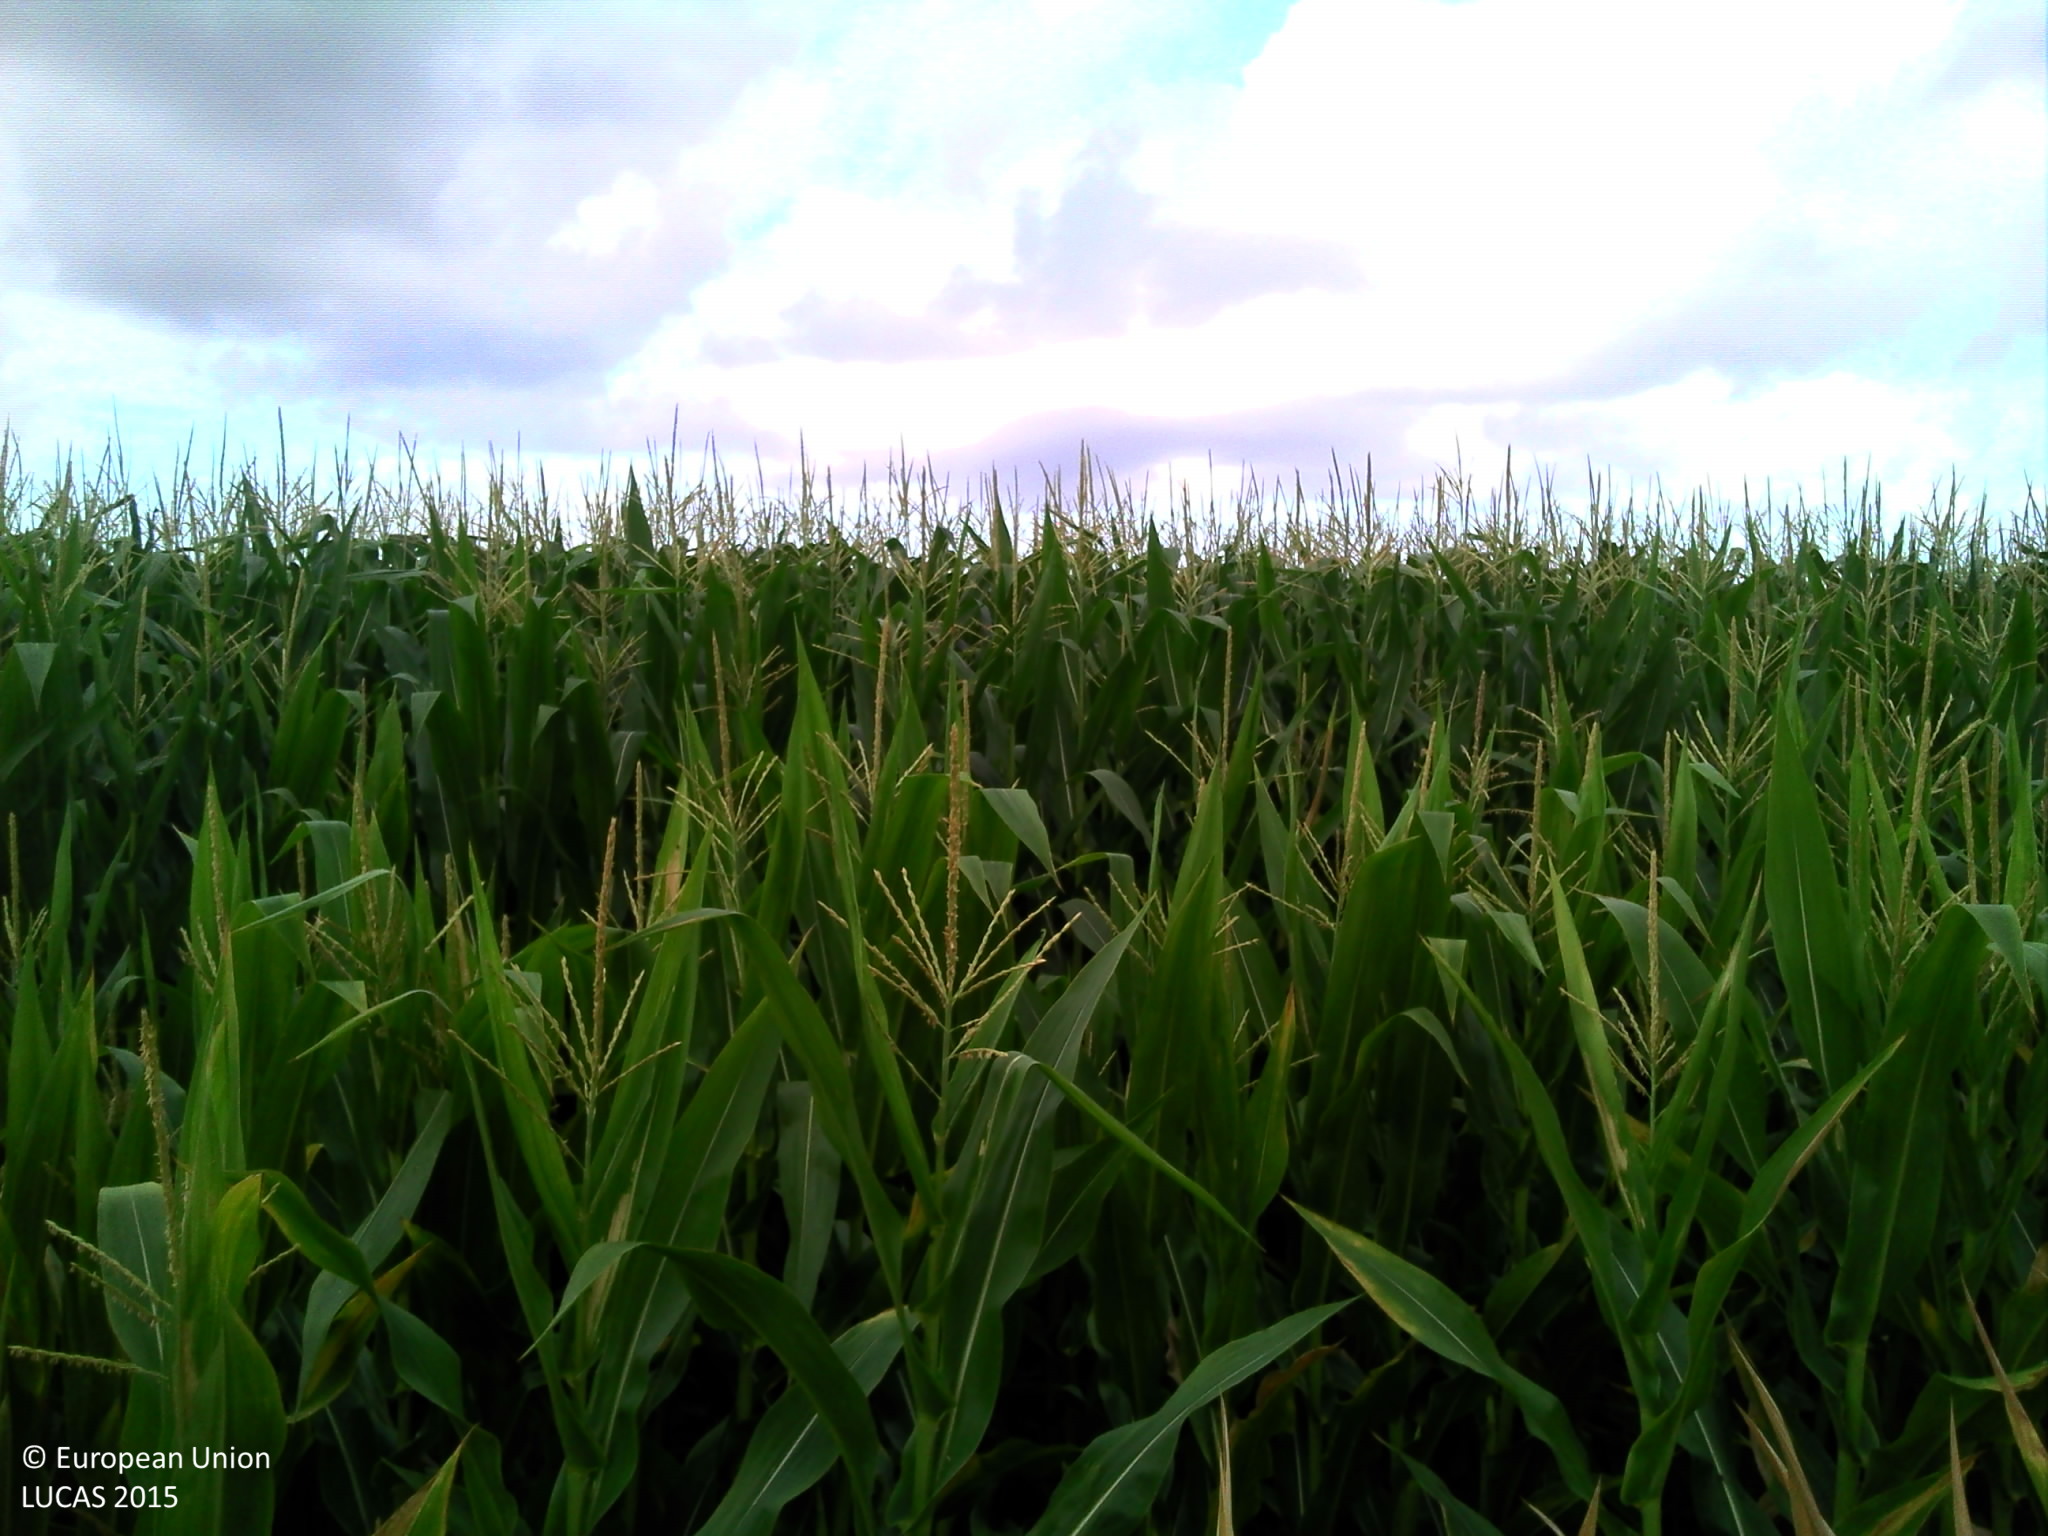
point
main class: Cropland
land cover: Maize
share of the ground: > 75 %
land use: Agriculture (excluding fallow land and kitchen gardens)
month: July
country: FR
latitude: 44.3900
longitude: -0.9280
